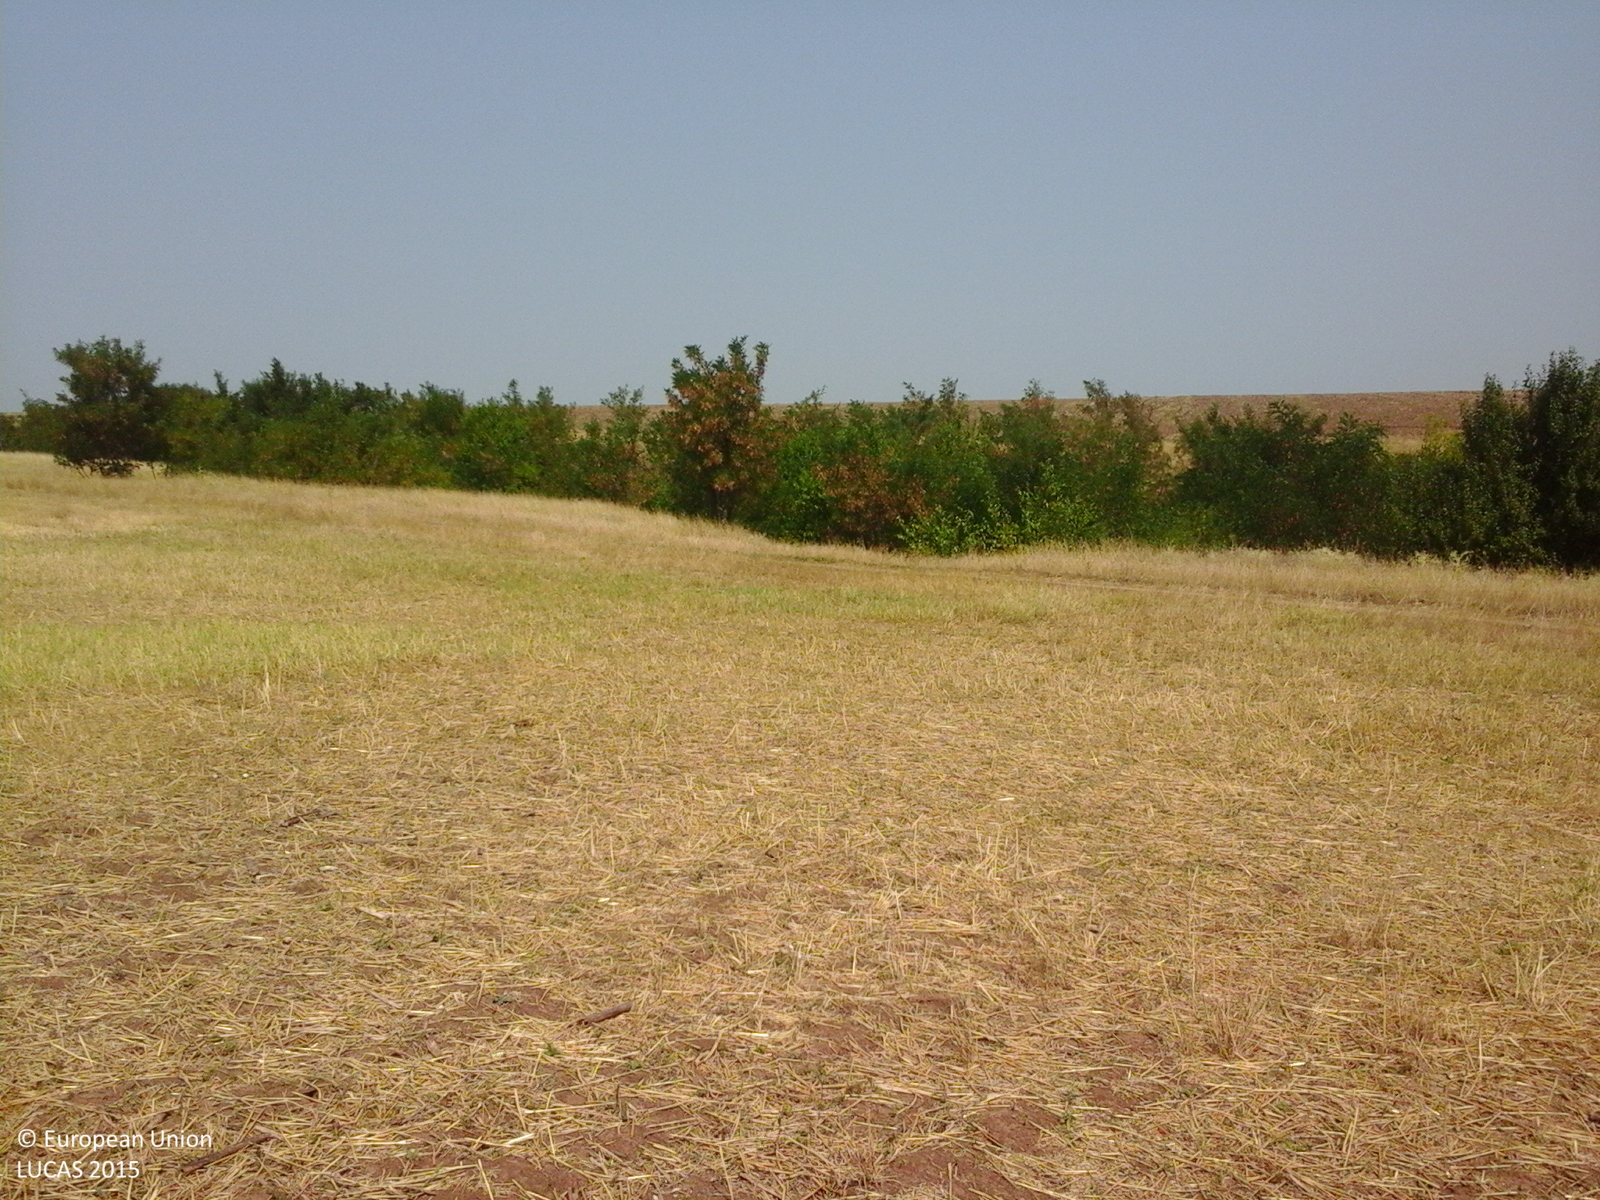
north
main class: Cropland
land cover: Common wheat
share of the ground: 50 - 75 %
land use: Agriculture (excluding fallow land and kitchen gardens)
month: August
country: RO
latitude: 44.3037
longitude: 23.5018
